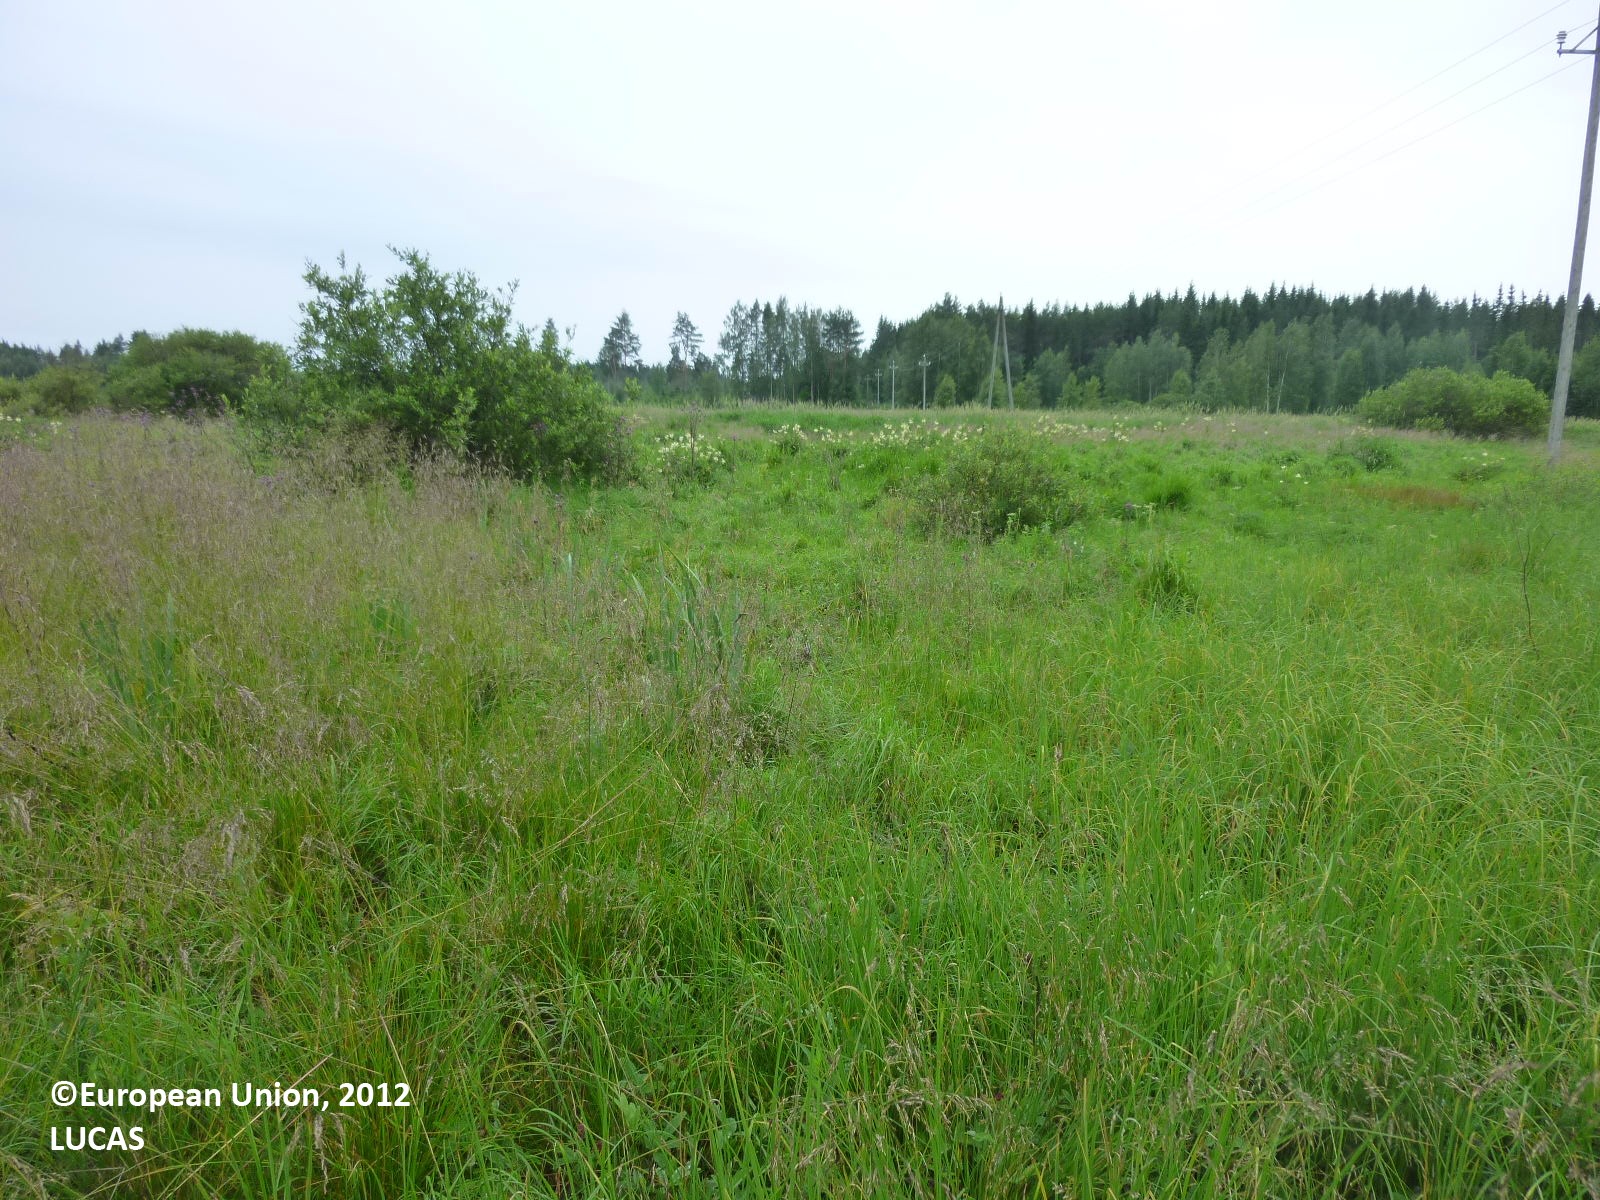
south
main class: Grassland
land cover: Grassland with sparse tree/shrub cover
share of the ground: > 75 %
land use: Fallow land
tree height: > 5 m
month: July
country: FI
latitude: 61.4210
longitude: 22.1839
